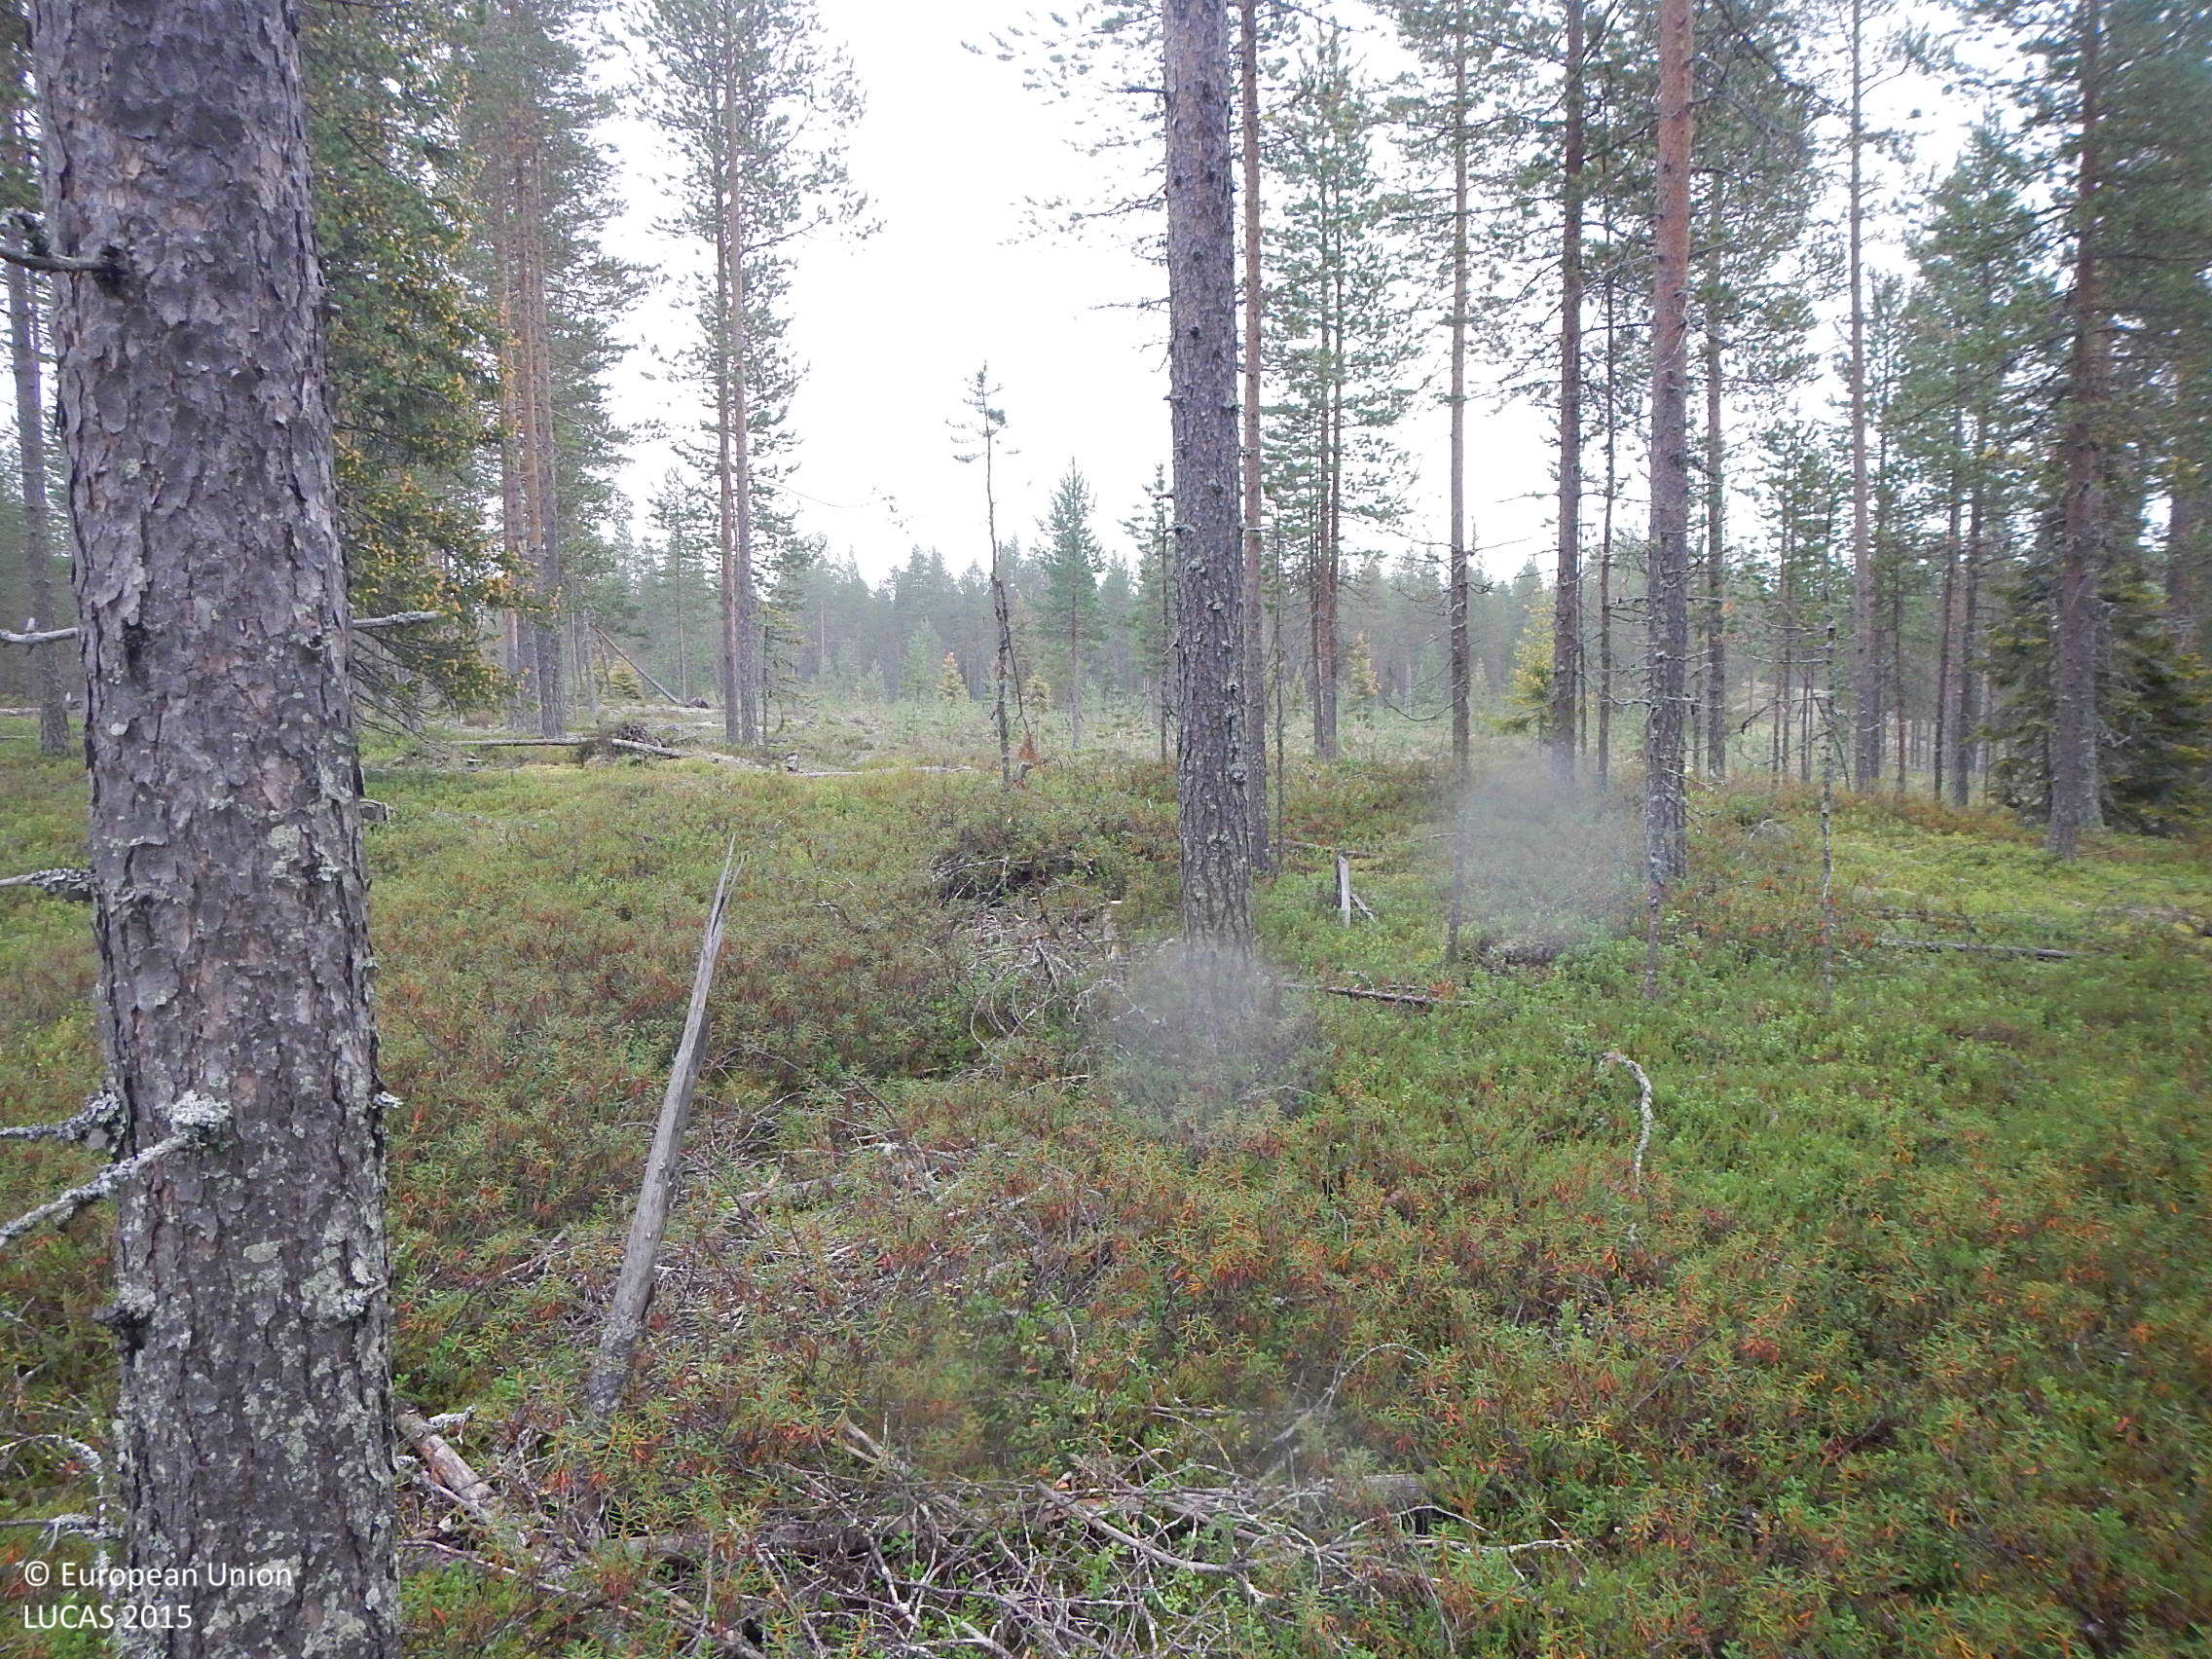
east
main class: Woodland
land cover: Pine dominated coniferous woodland
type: boreal forest
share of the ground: 25 - 50 %
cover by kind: shrubs 65 %, coniferous forest trees 30 %, lichens and mosses 5 %
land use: Forestry
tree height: > 5 m
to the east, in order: Pine dominated coniferous woodland; Peatbogs; Other mixed woodland; Pine dominated coniferous woodland; Ditches and canals; Pine dominated coniferous woodland
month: August
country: FI
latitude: 66.0149
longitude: 27.5621
